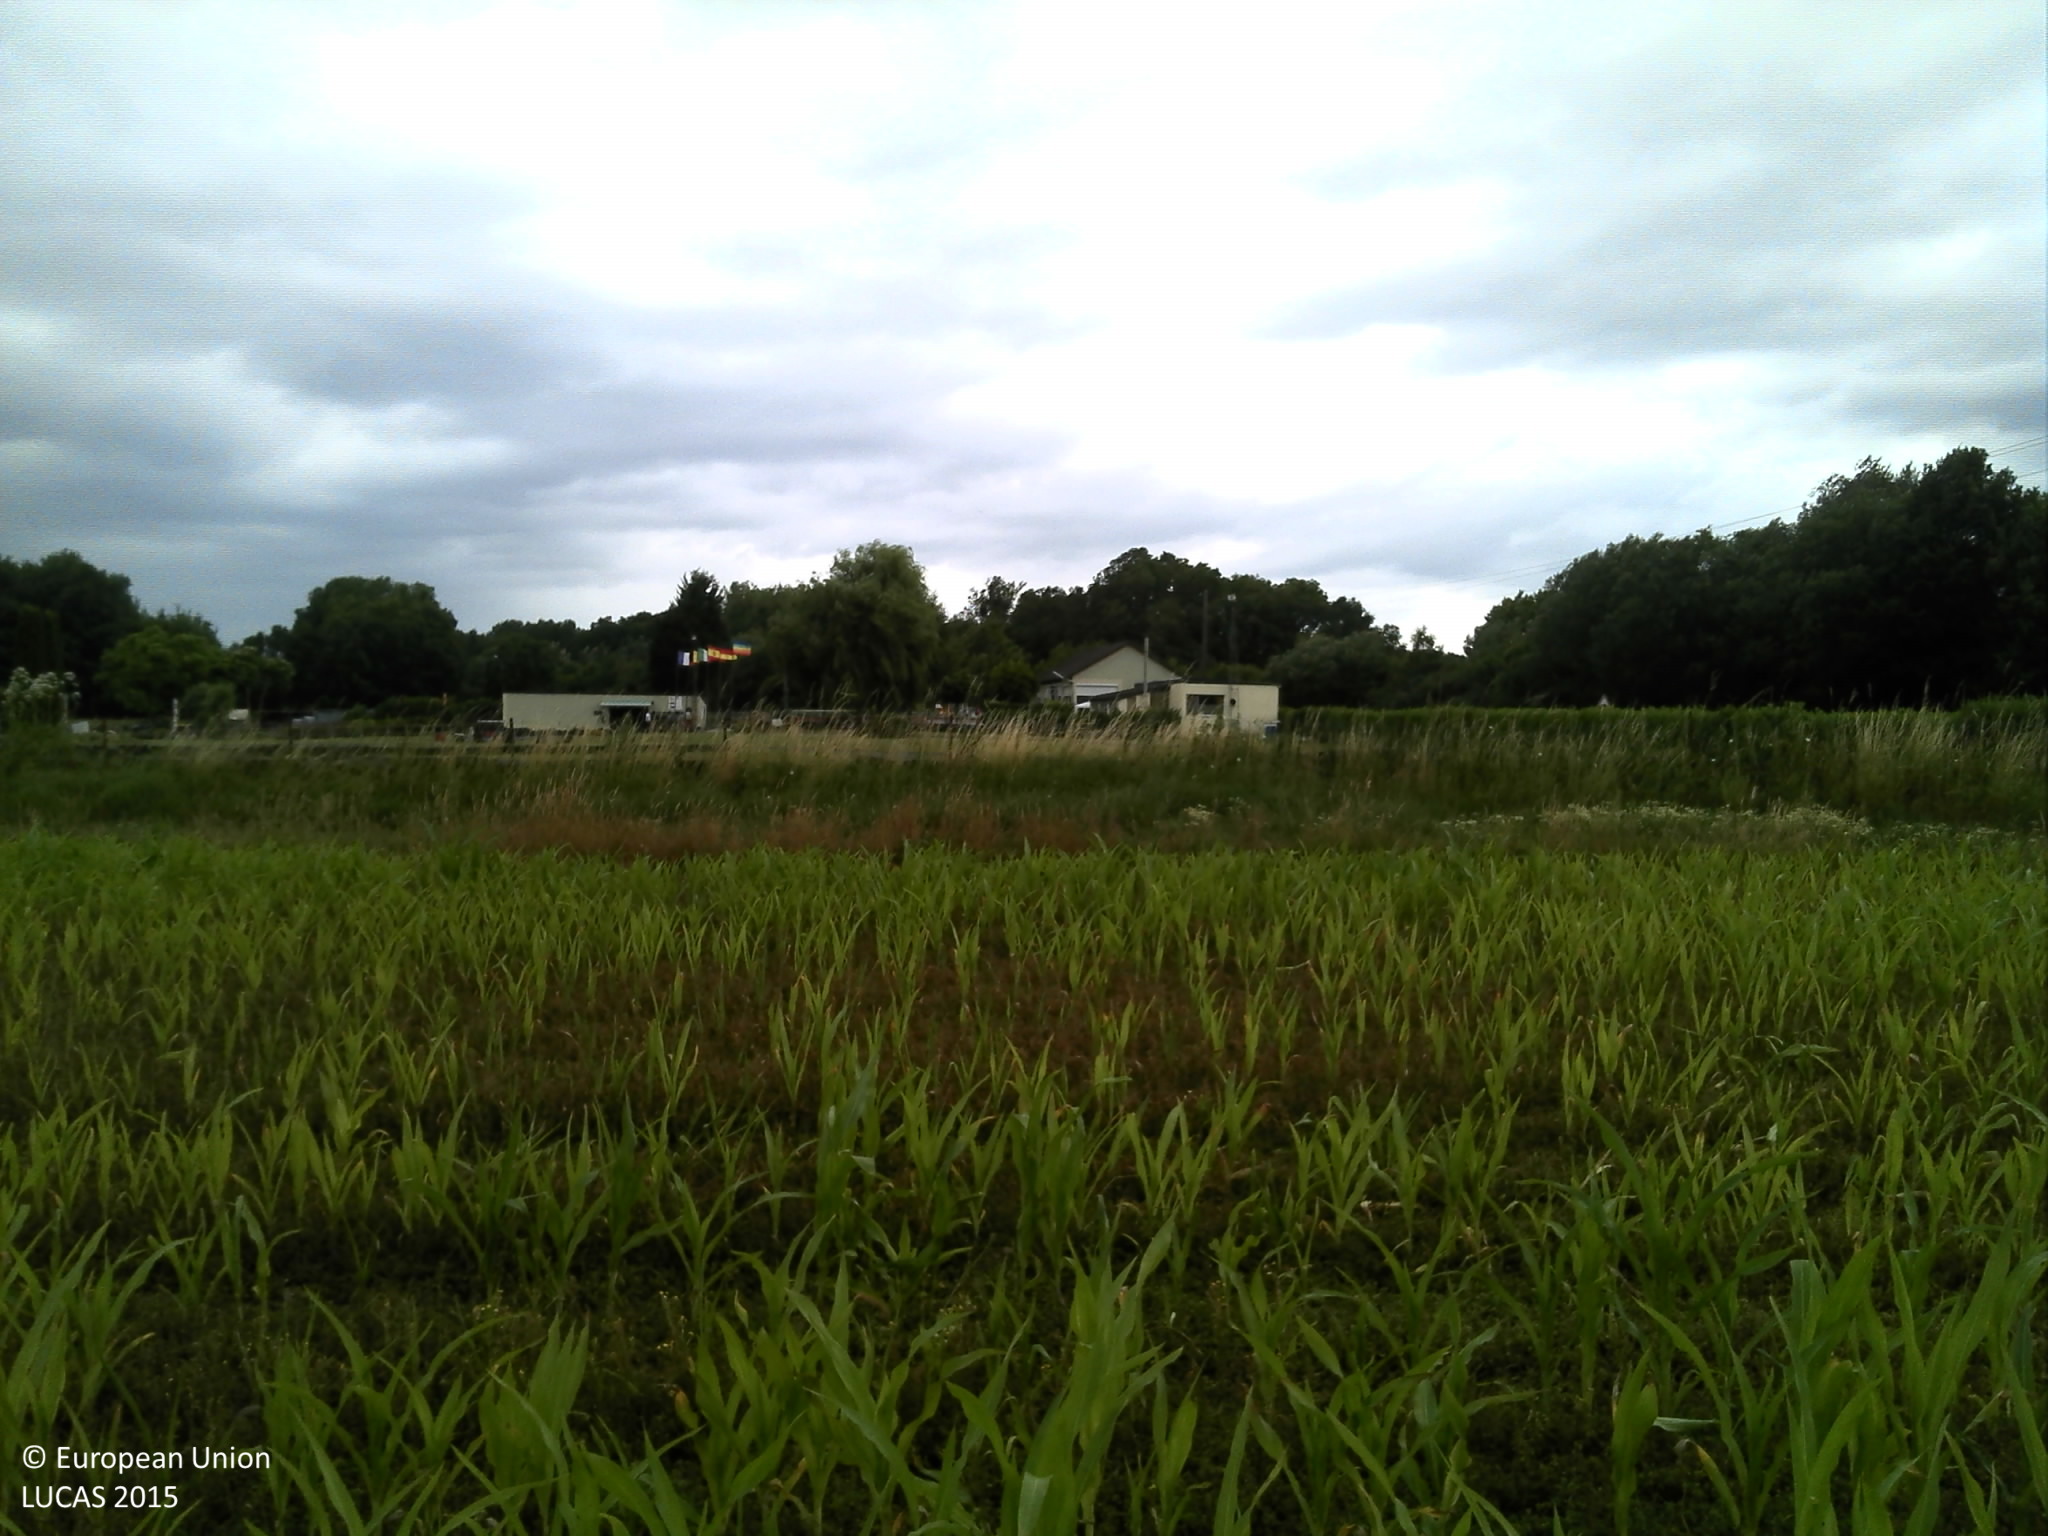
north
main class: Cropland
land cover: Maize
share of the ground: 25 - 50 %
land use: Agriculture (excluding fallow land and kitchen gardens)
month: July
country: FR
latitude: 49.8036
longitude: 4.5914
